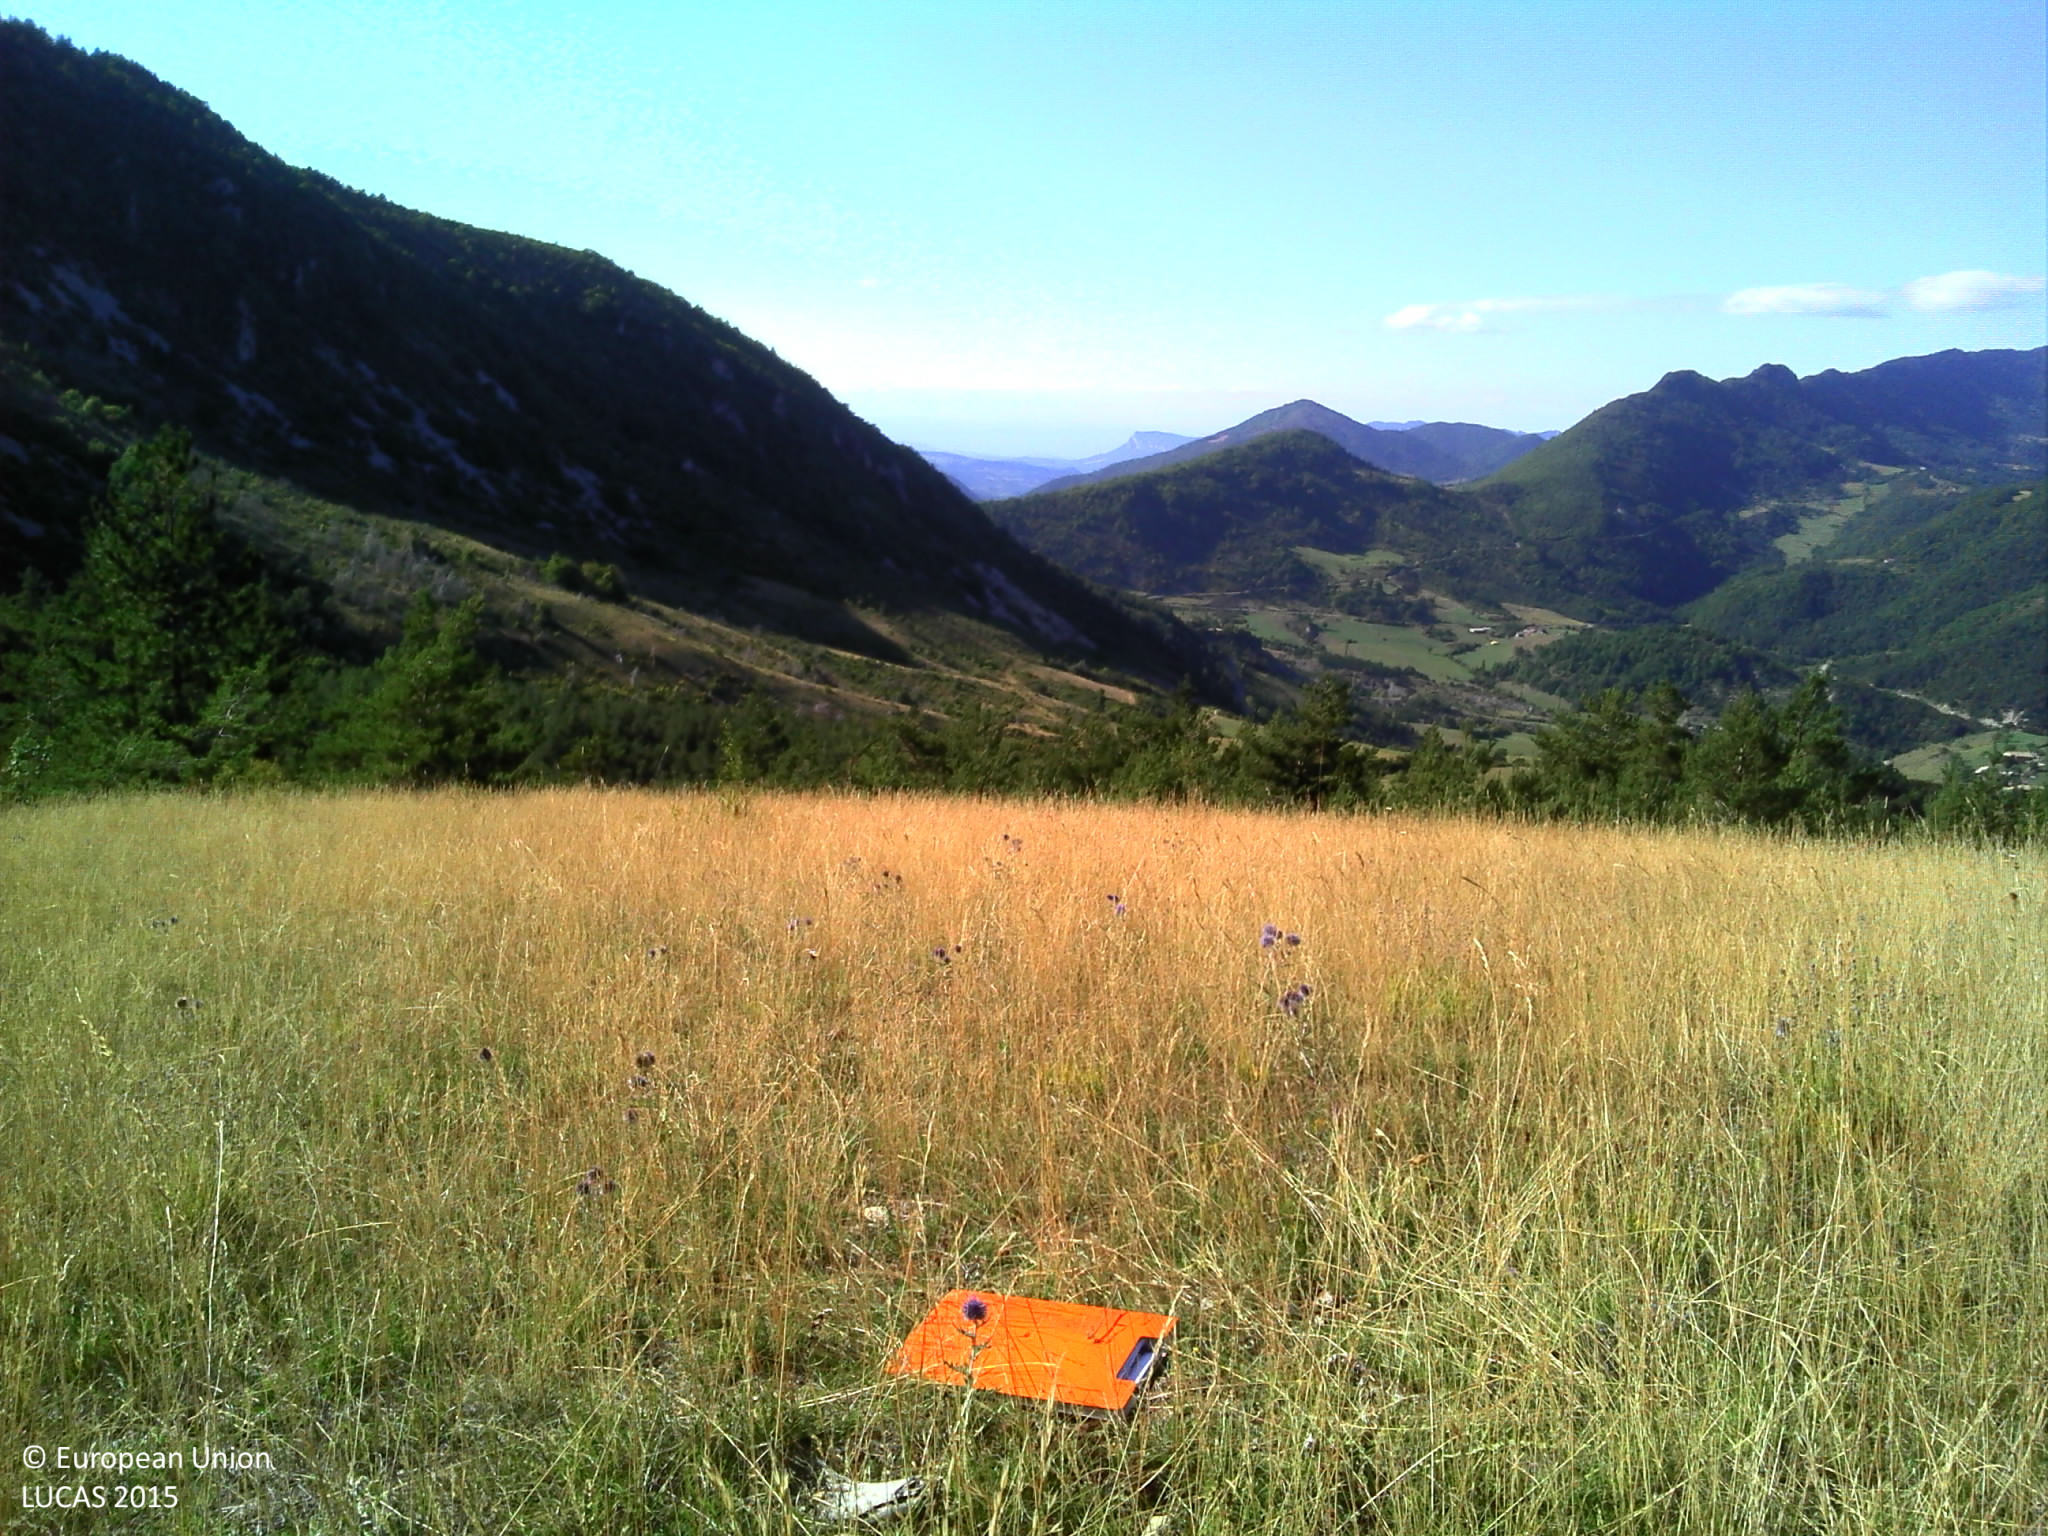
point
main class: Grassland
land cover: Grassland without tree/shrub cover
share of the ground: > 75 %
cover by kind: herbaceous plants 95 %, shrubs 5 %
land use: Agriculture (excluding fallow land and kitchen gardens)
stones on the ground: 25 - 50 %
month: September
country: FR
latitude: 44.4954
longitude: 5.2659
